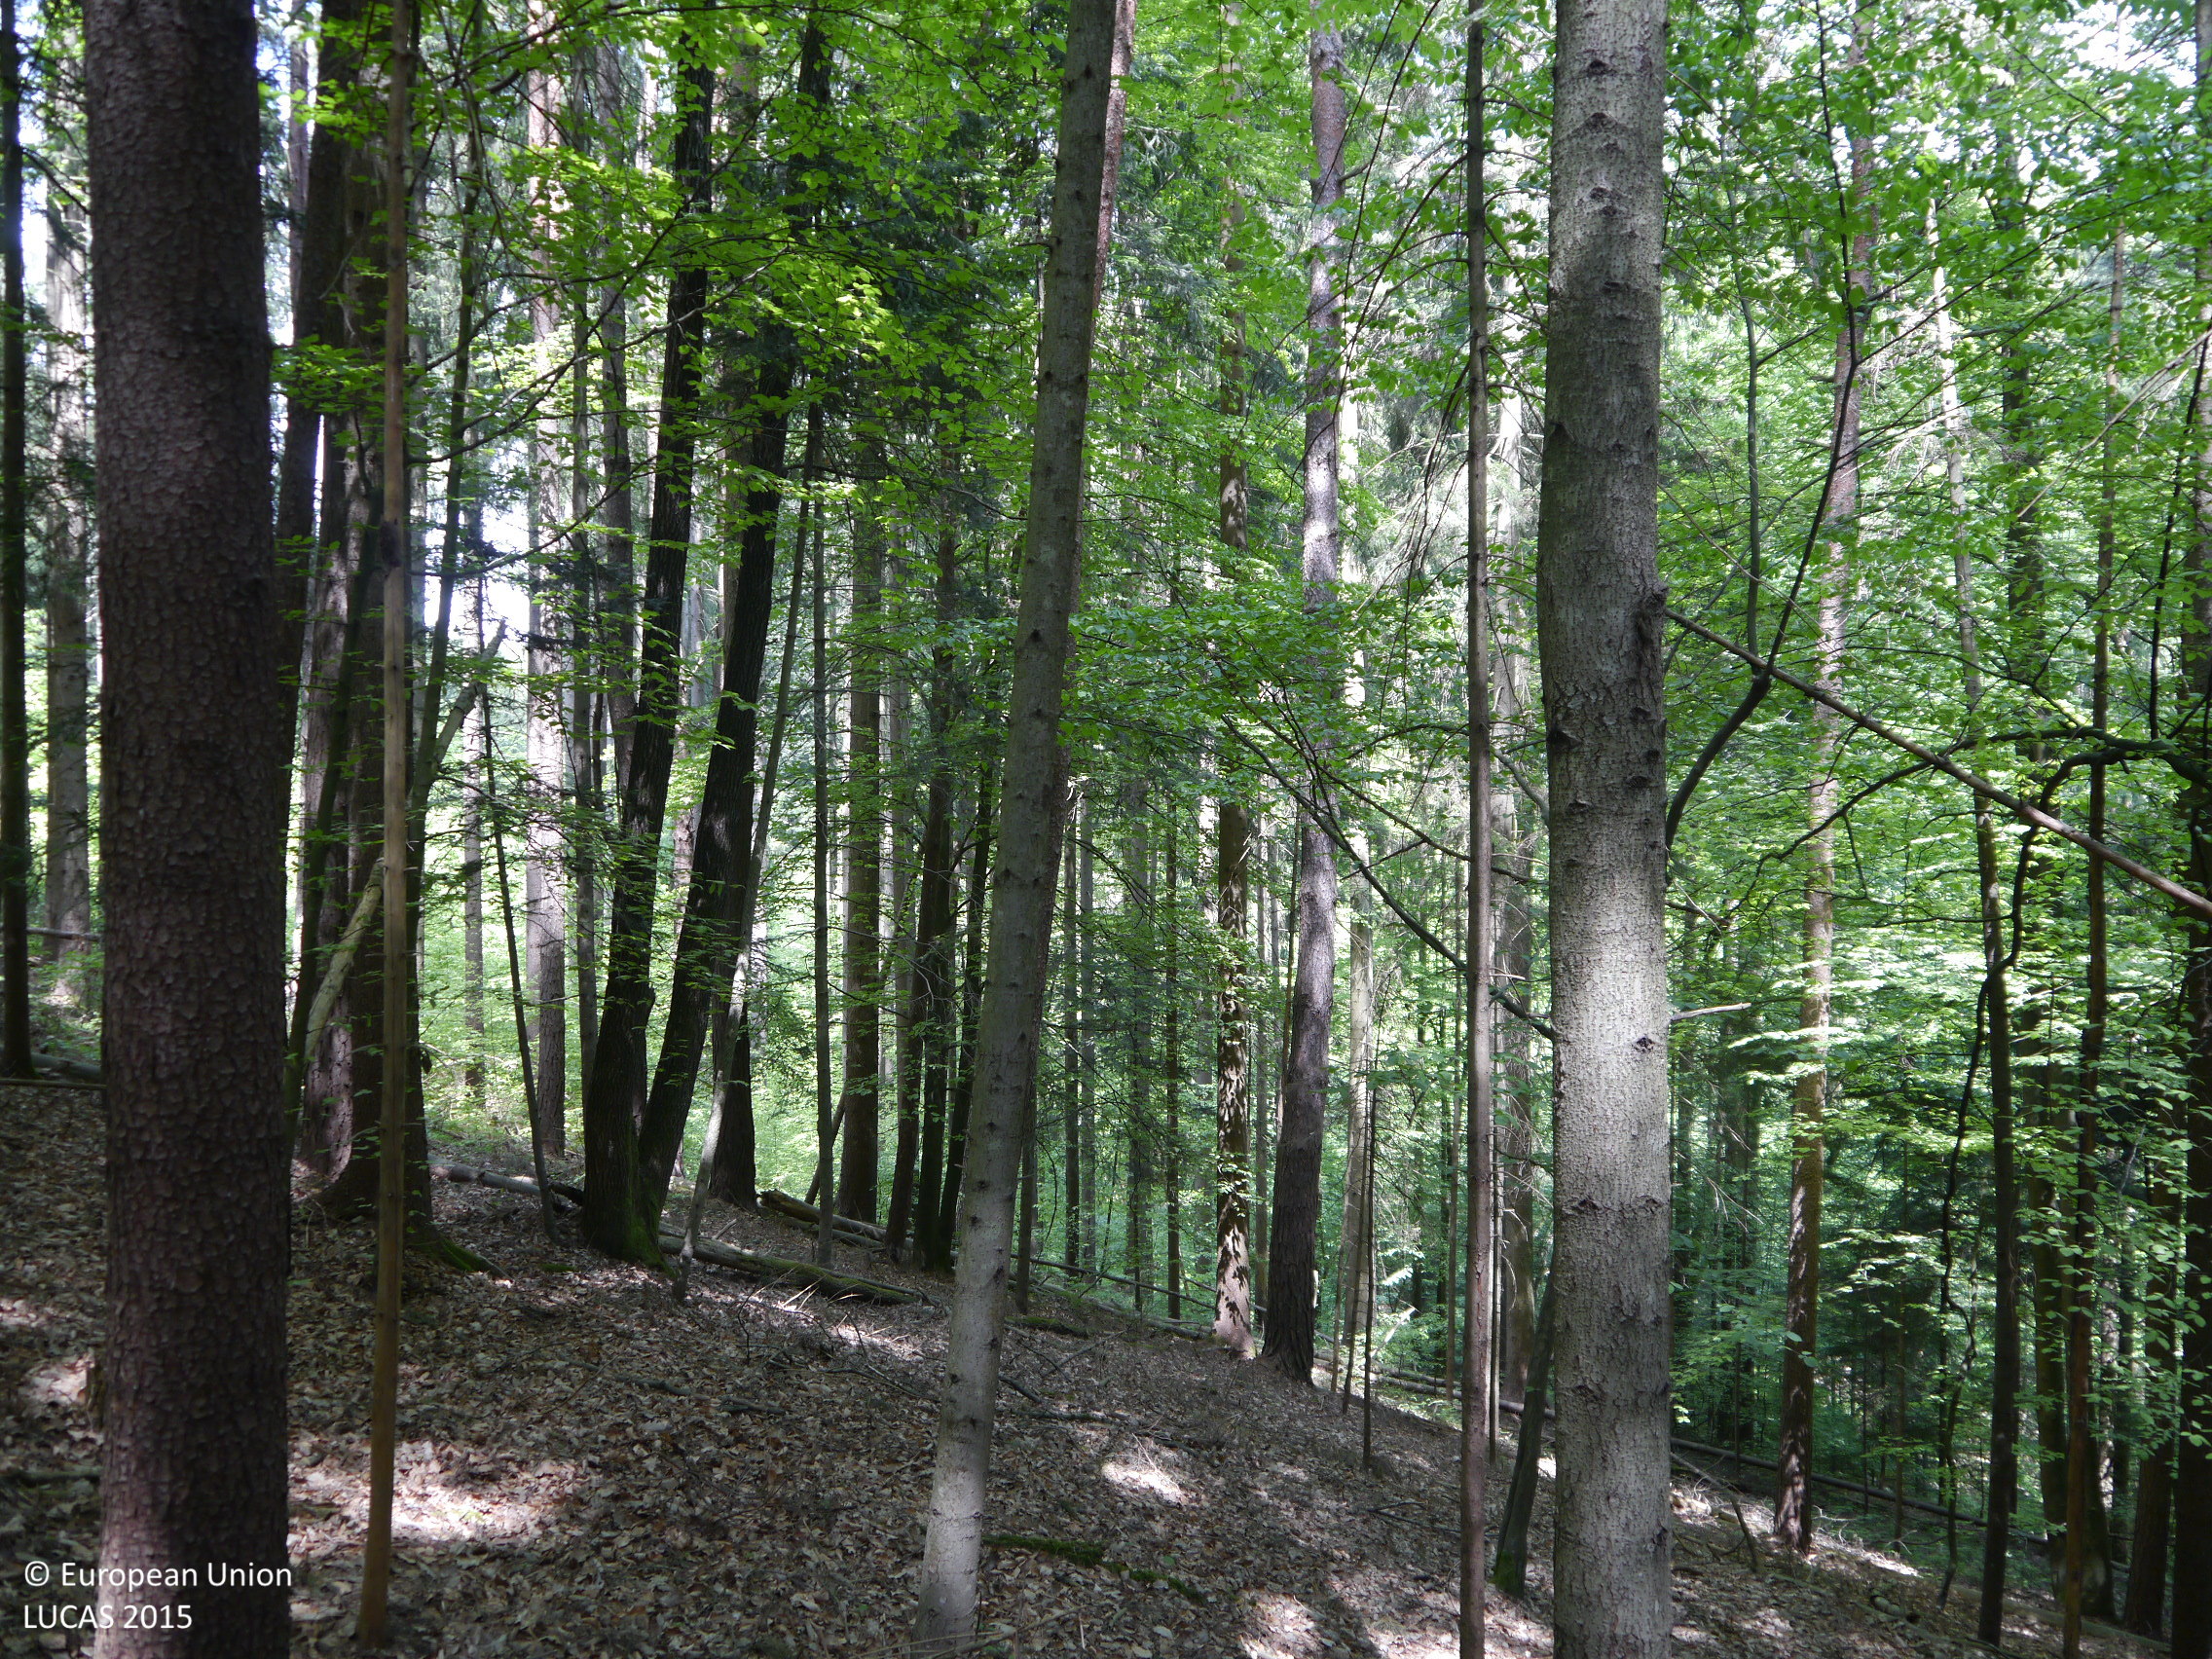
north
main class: Woodland
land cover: Spruce dominated mixed woodland
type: hemiboreal forest and nemoral coniferous forest and mixed broadleaved-coniferous forest
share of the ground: > 75 %
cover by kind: coniferous forest trees 70 %, broadleaved forest trees 30 %
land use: Forestry
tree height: > 5 m
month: May
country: AT
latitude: 47.1049
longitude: 15.2836
